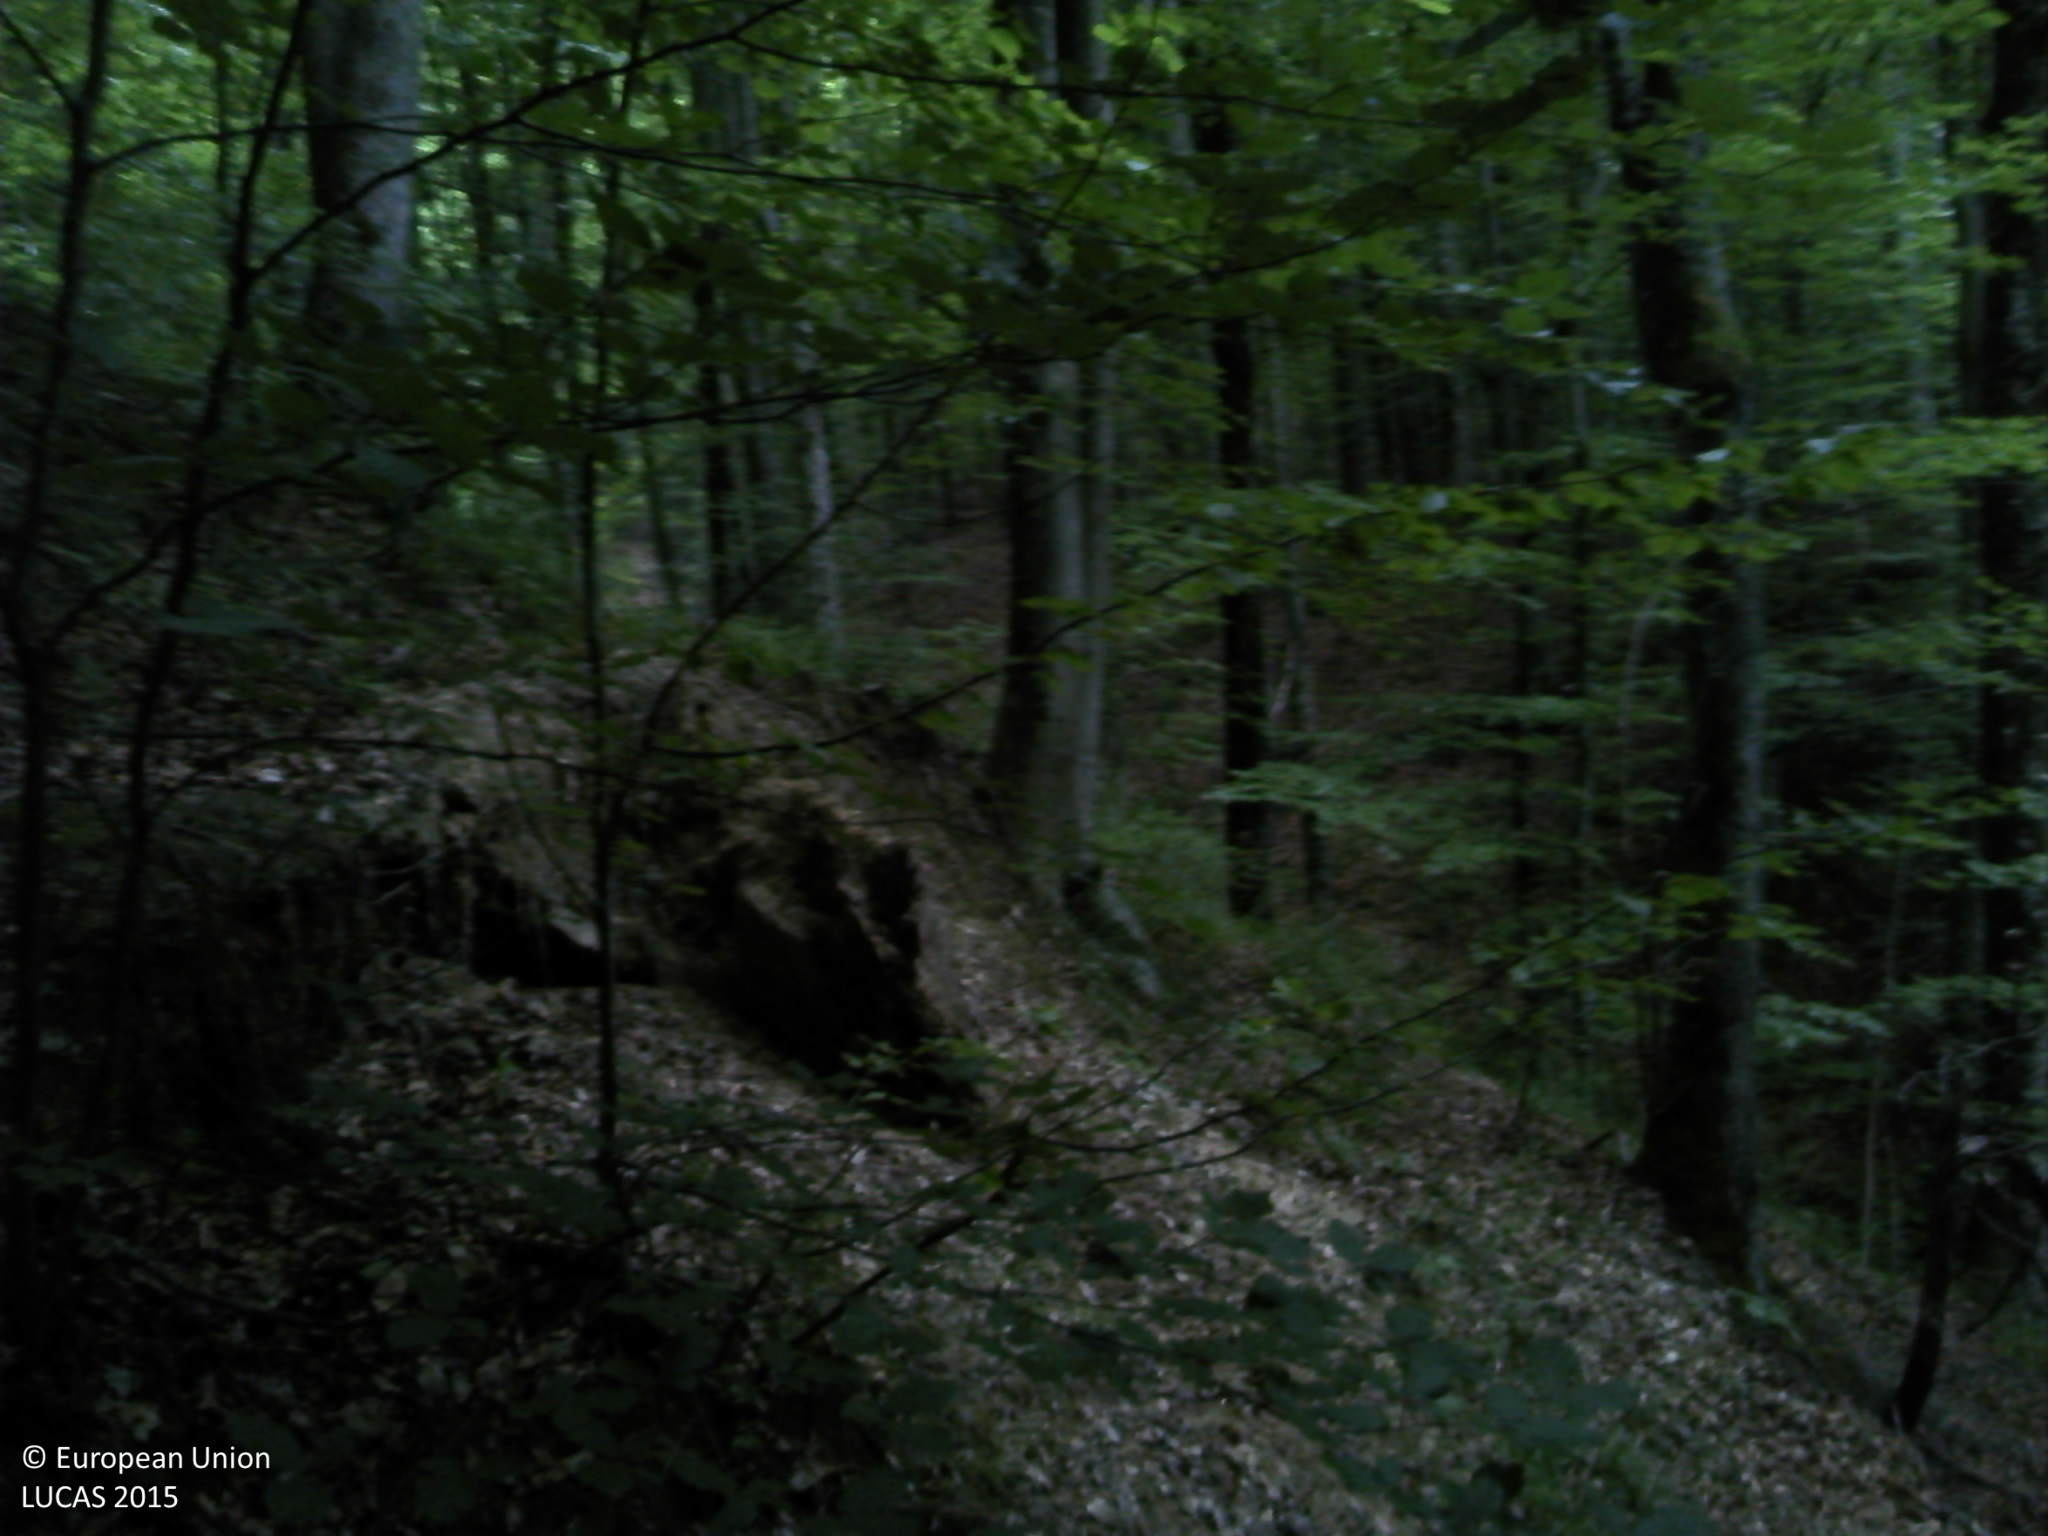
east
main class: Woodland
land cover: Broadleaved woodland
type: acidophilous oak and oak-birch forest
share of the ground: > 75 %
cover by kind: broadleaved forest trees 100 %
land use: Forestry
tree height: > 5 m
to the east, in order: Broadleaved woodland
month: June
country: HR
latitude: 45.5257
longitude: 17.5173
